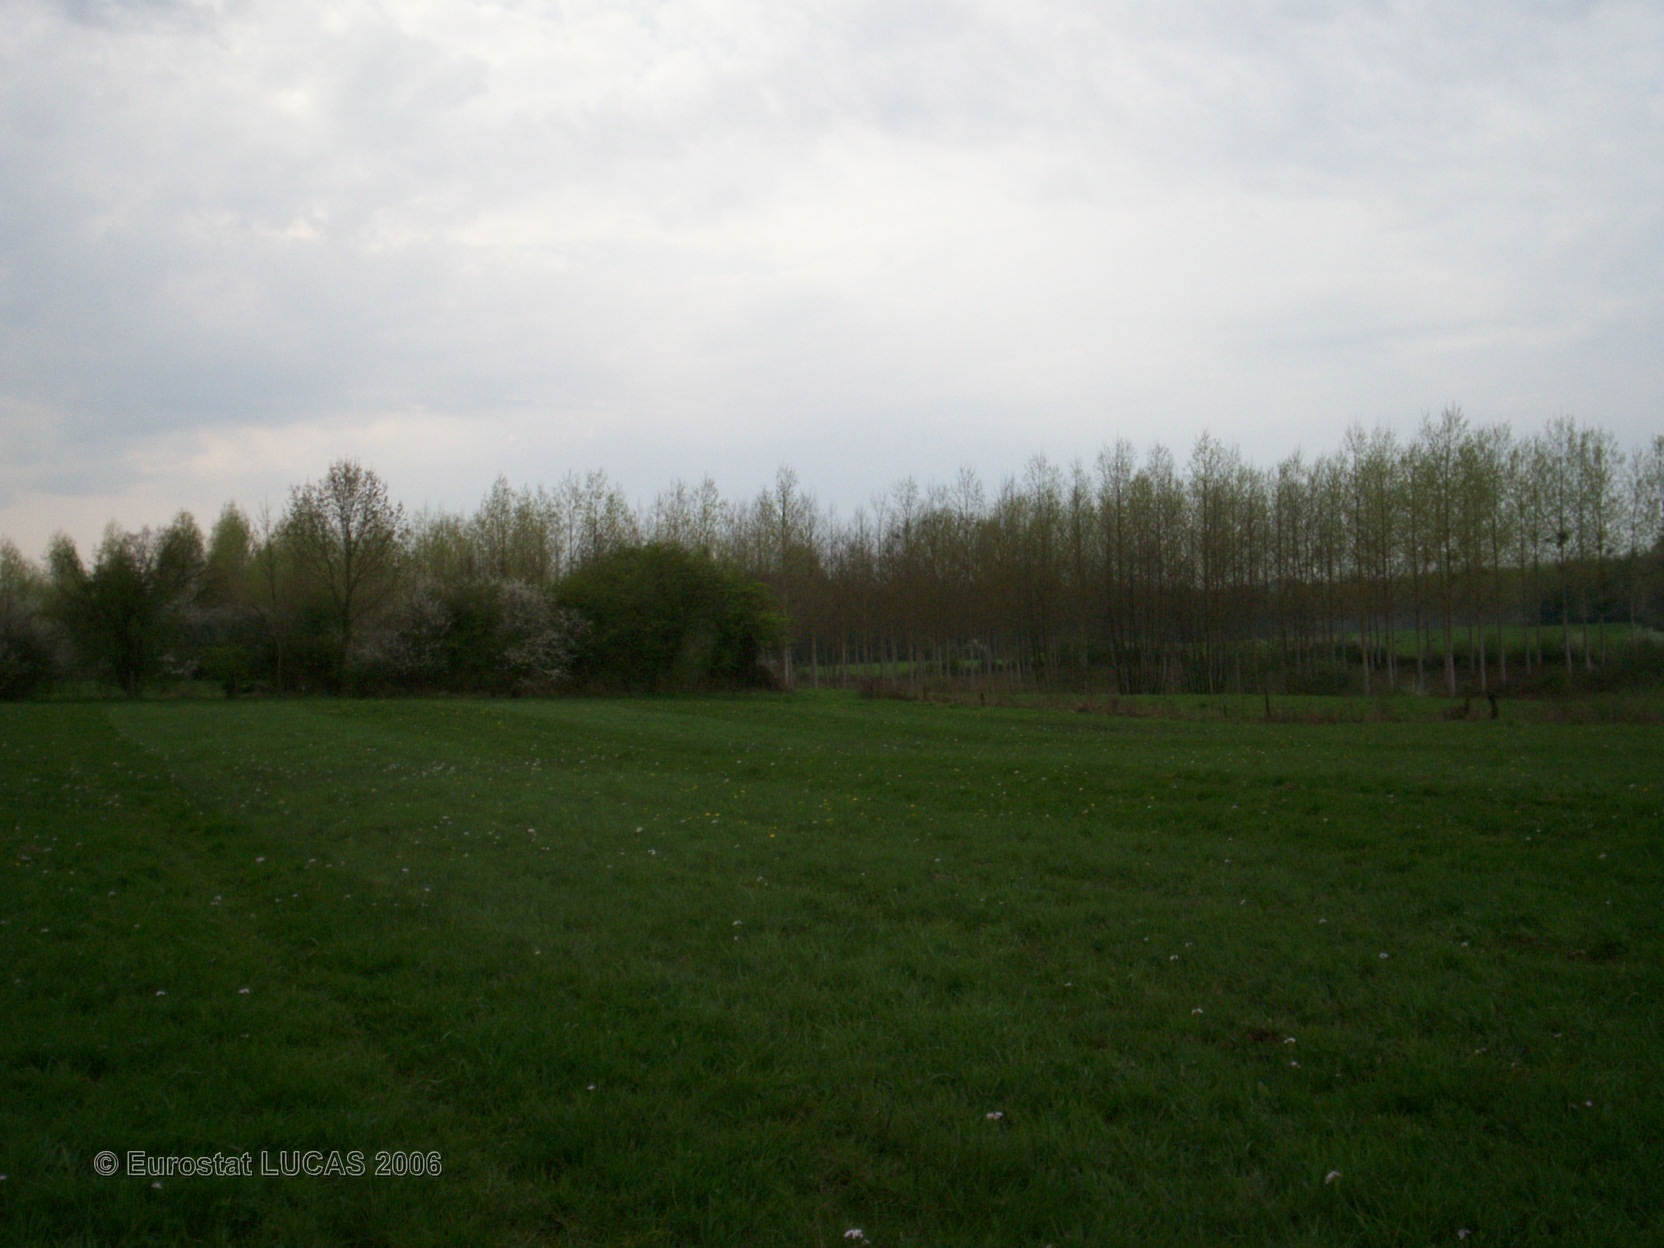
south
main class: Grassland
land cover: Grassland without tree/shrub cover
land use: Agriculture (excluding fallow land and kitchen gardens)
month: May
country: FR
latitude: 49.8961
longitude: 4.2738
